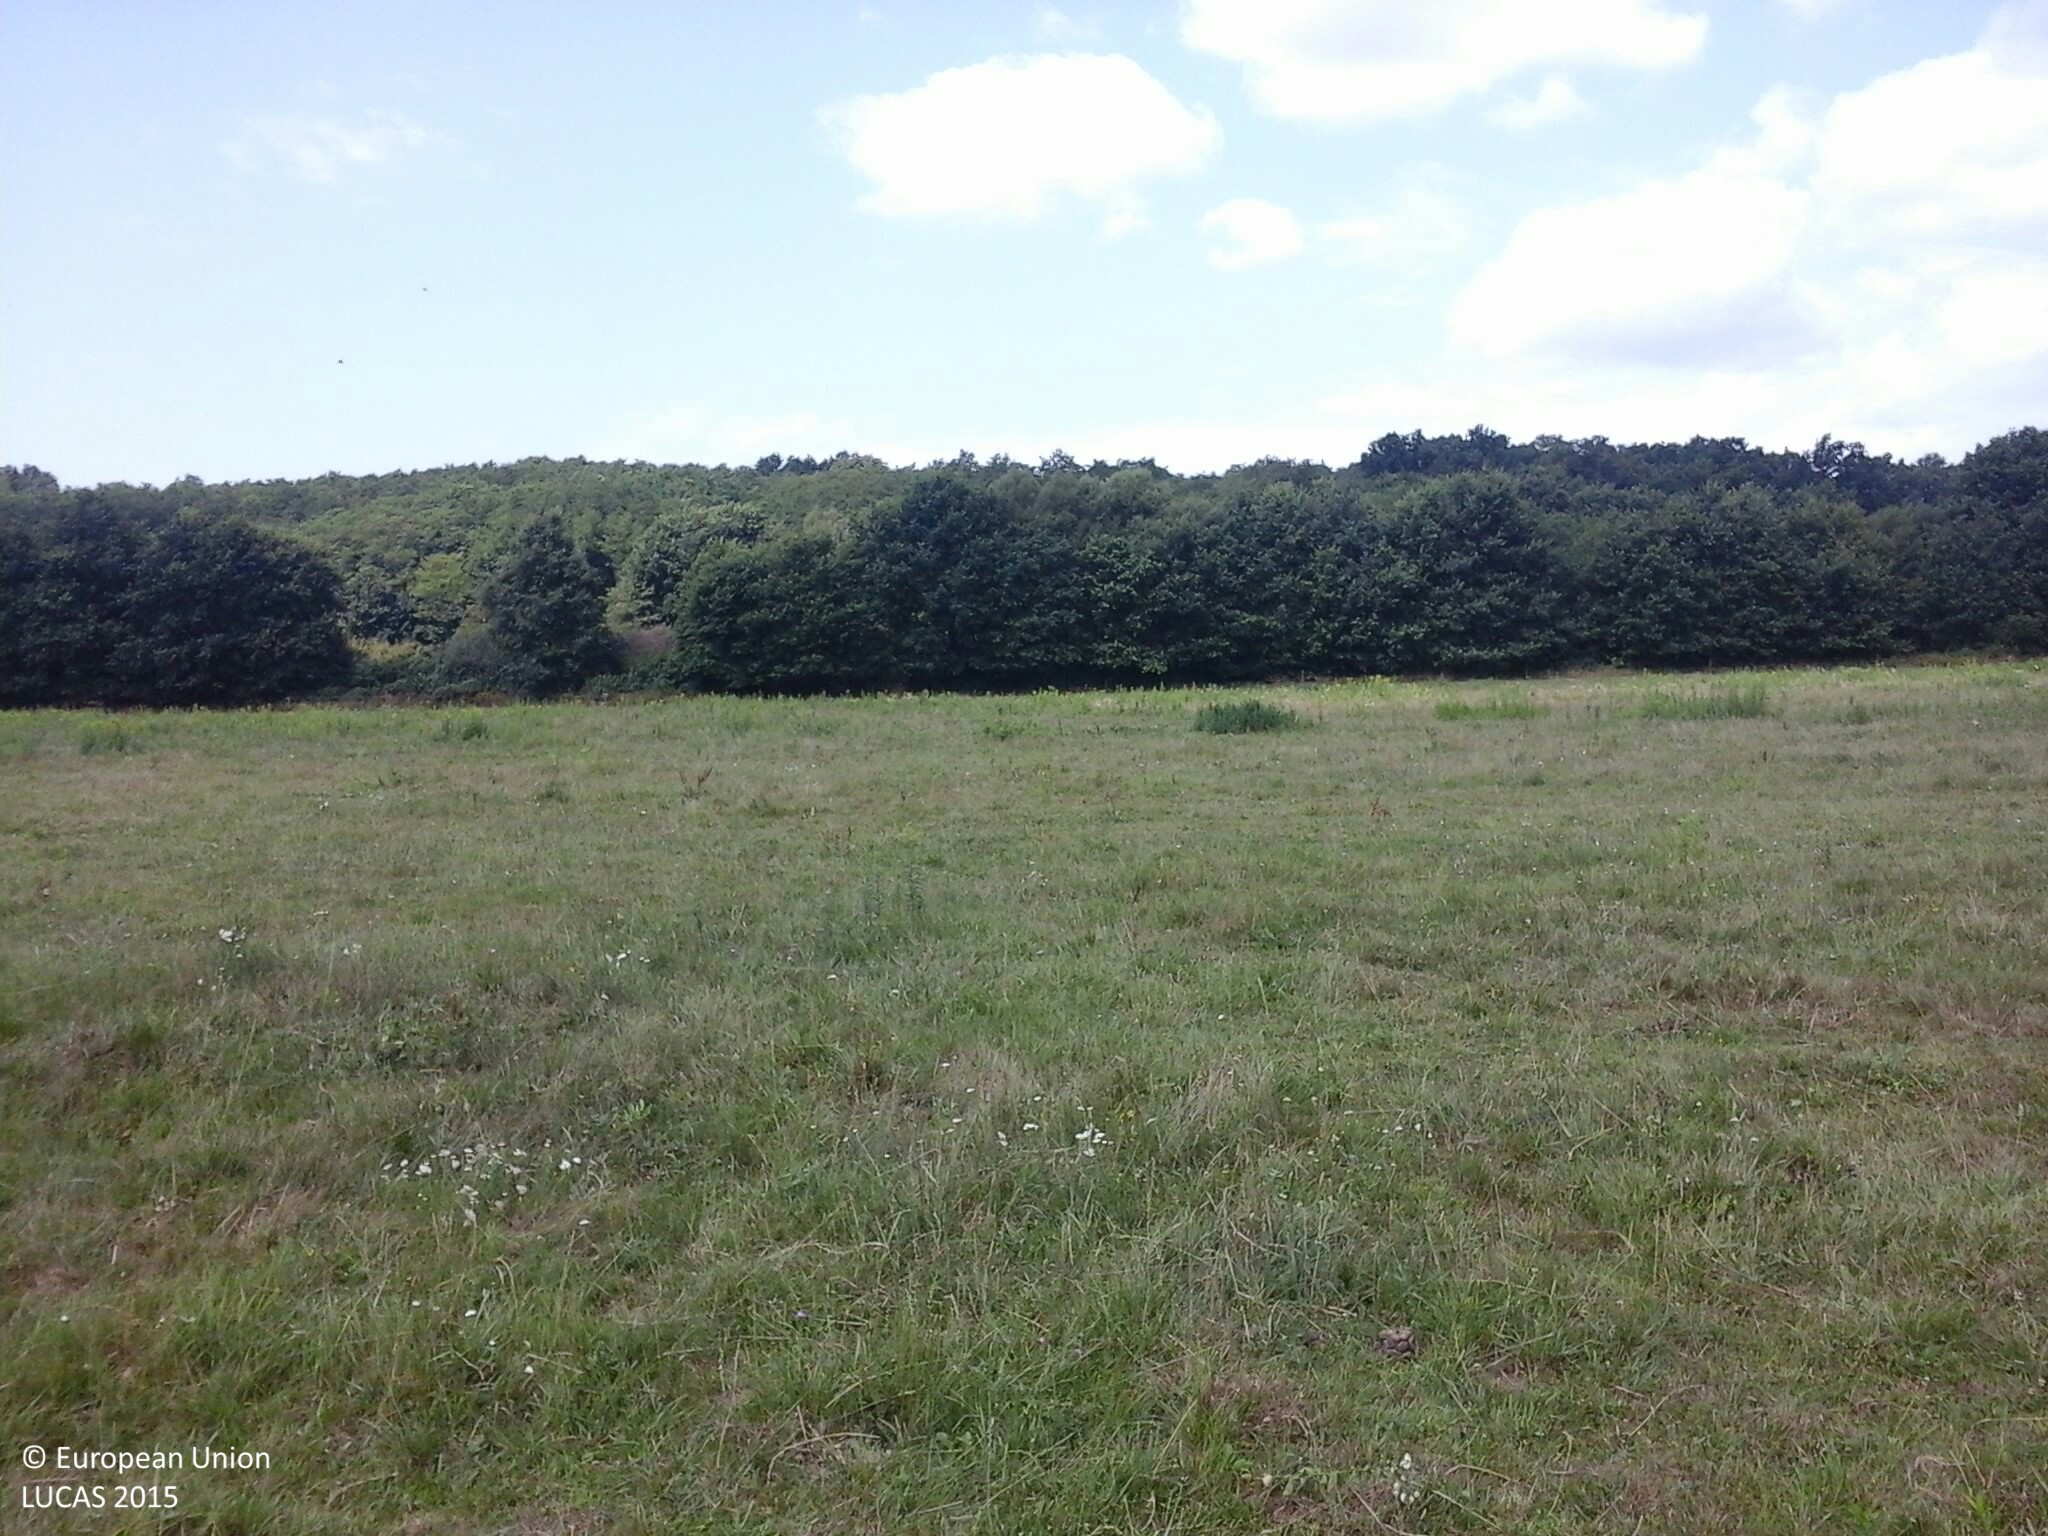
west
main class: Grassland
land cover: Grassland without tree/shrub cover
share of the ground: > 75 %
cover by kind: herbaceous plants 100 %
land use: Agriculture (excluding fallow land and kitchen gardens)
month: July
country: HU
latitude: 47.0407
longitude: 16.4646
